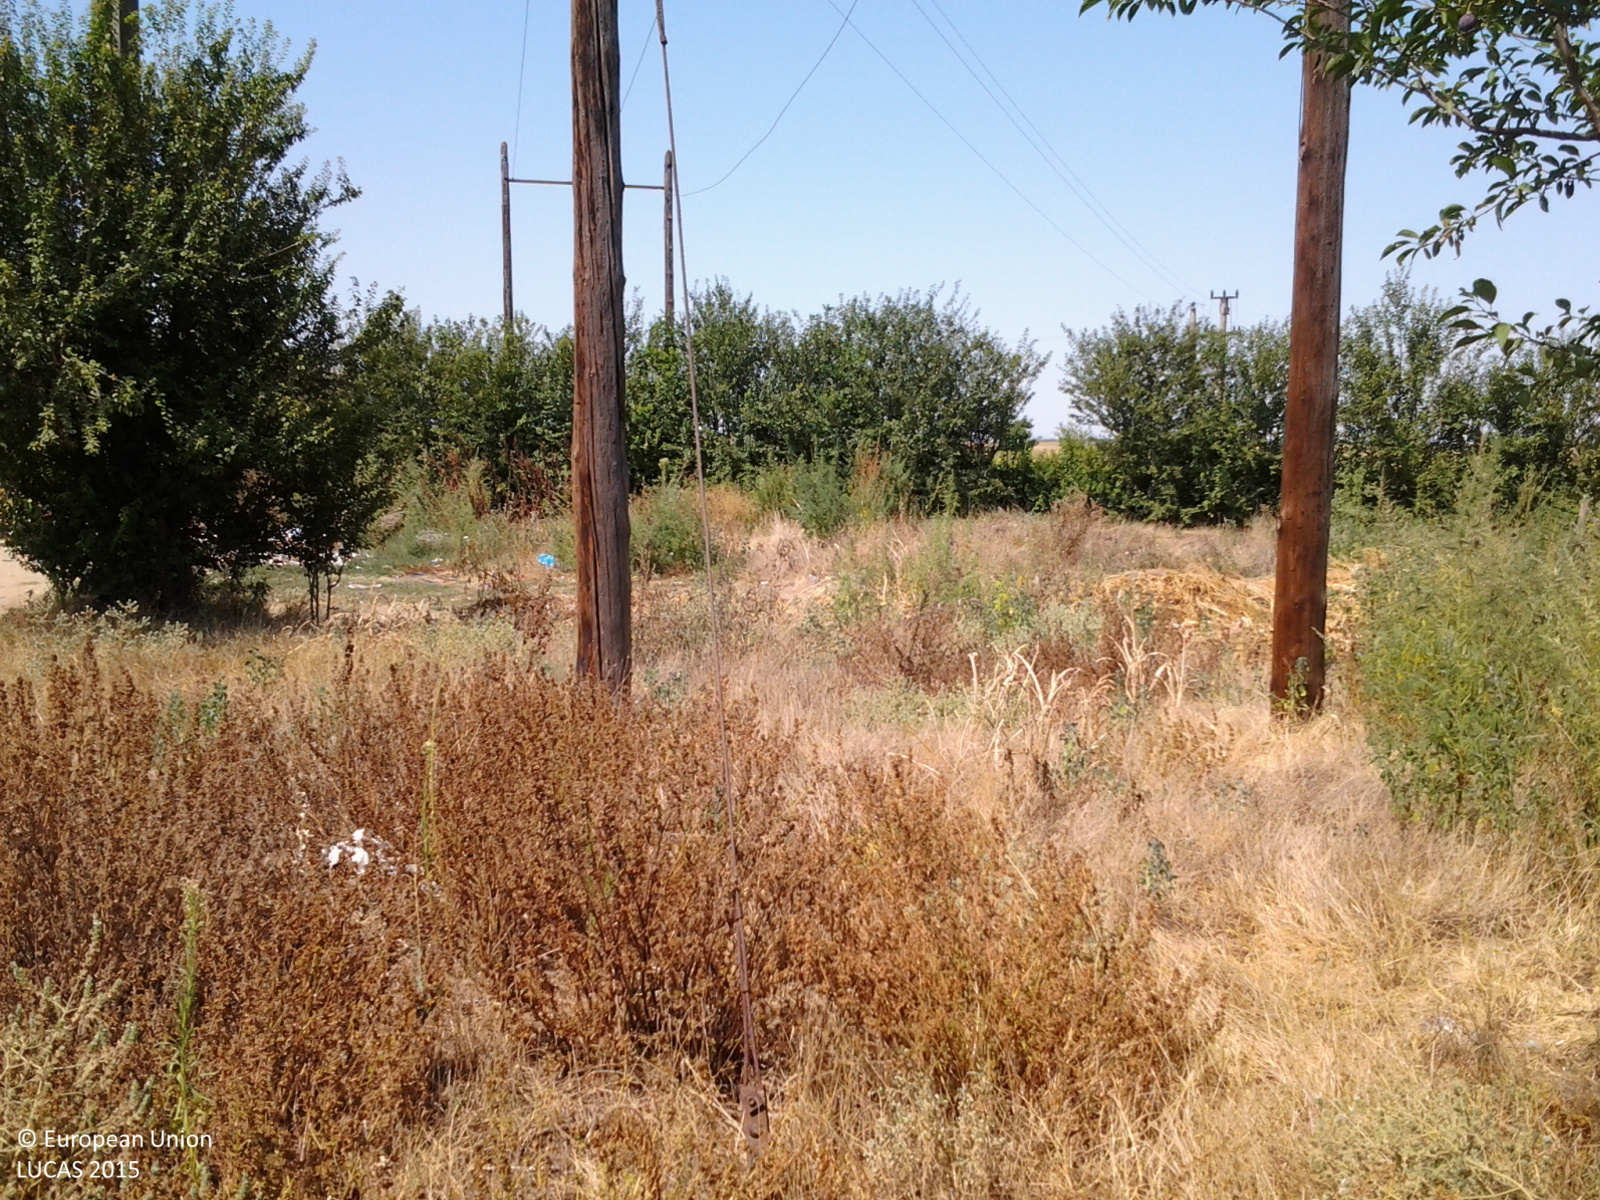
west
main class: Grassland
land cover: Spontaneously vegetated surfaces
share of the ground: > 75 %
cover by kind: herbaceous plants 100 %
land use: Semi-natural and natural areas not in use
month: August
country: RO
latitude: 43.9356
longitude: 22.9586
